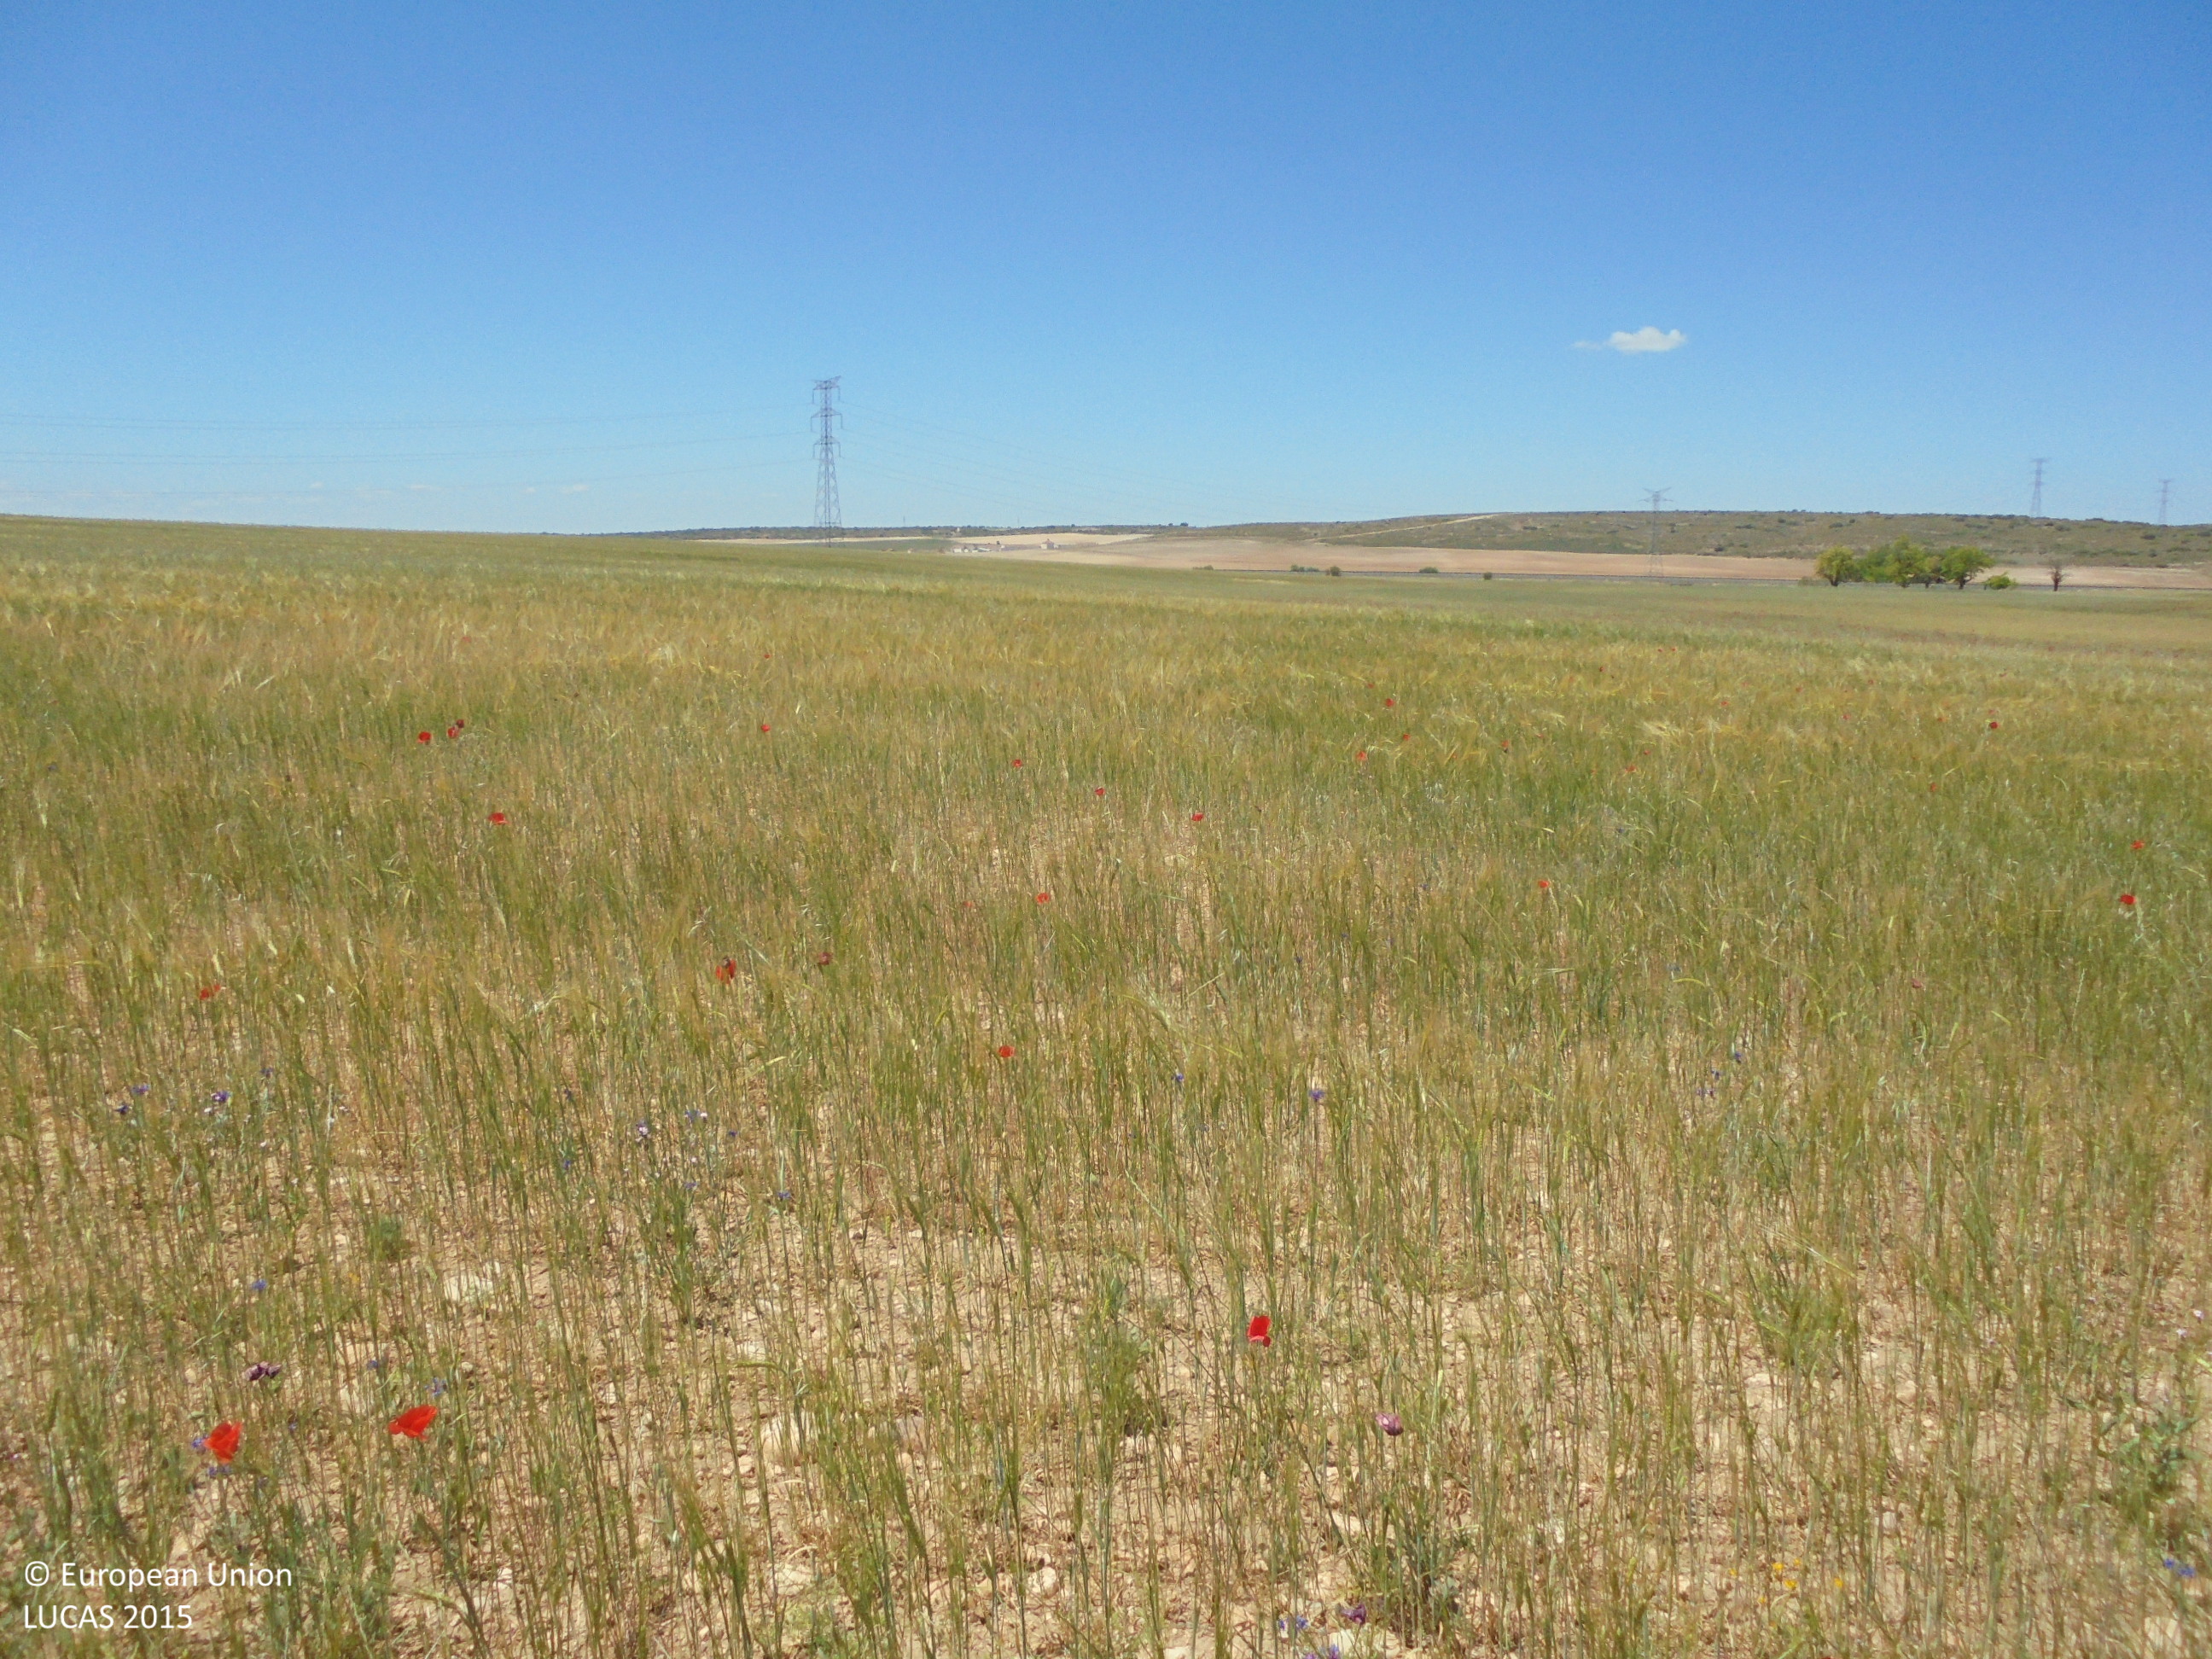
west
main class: Cropland
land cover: Barley
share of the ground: 25 - 50 %
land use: Agriculture (excluding fallow land and kitchen gardens)
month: May
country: ES
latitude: 38.8708
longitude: -1.6964
